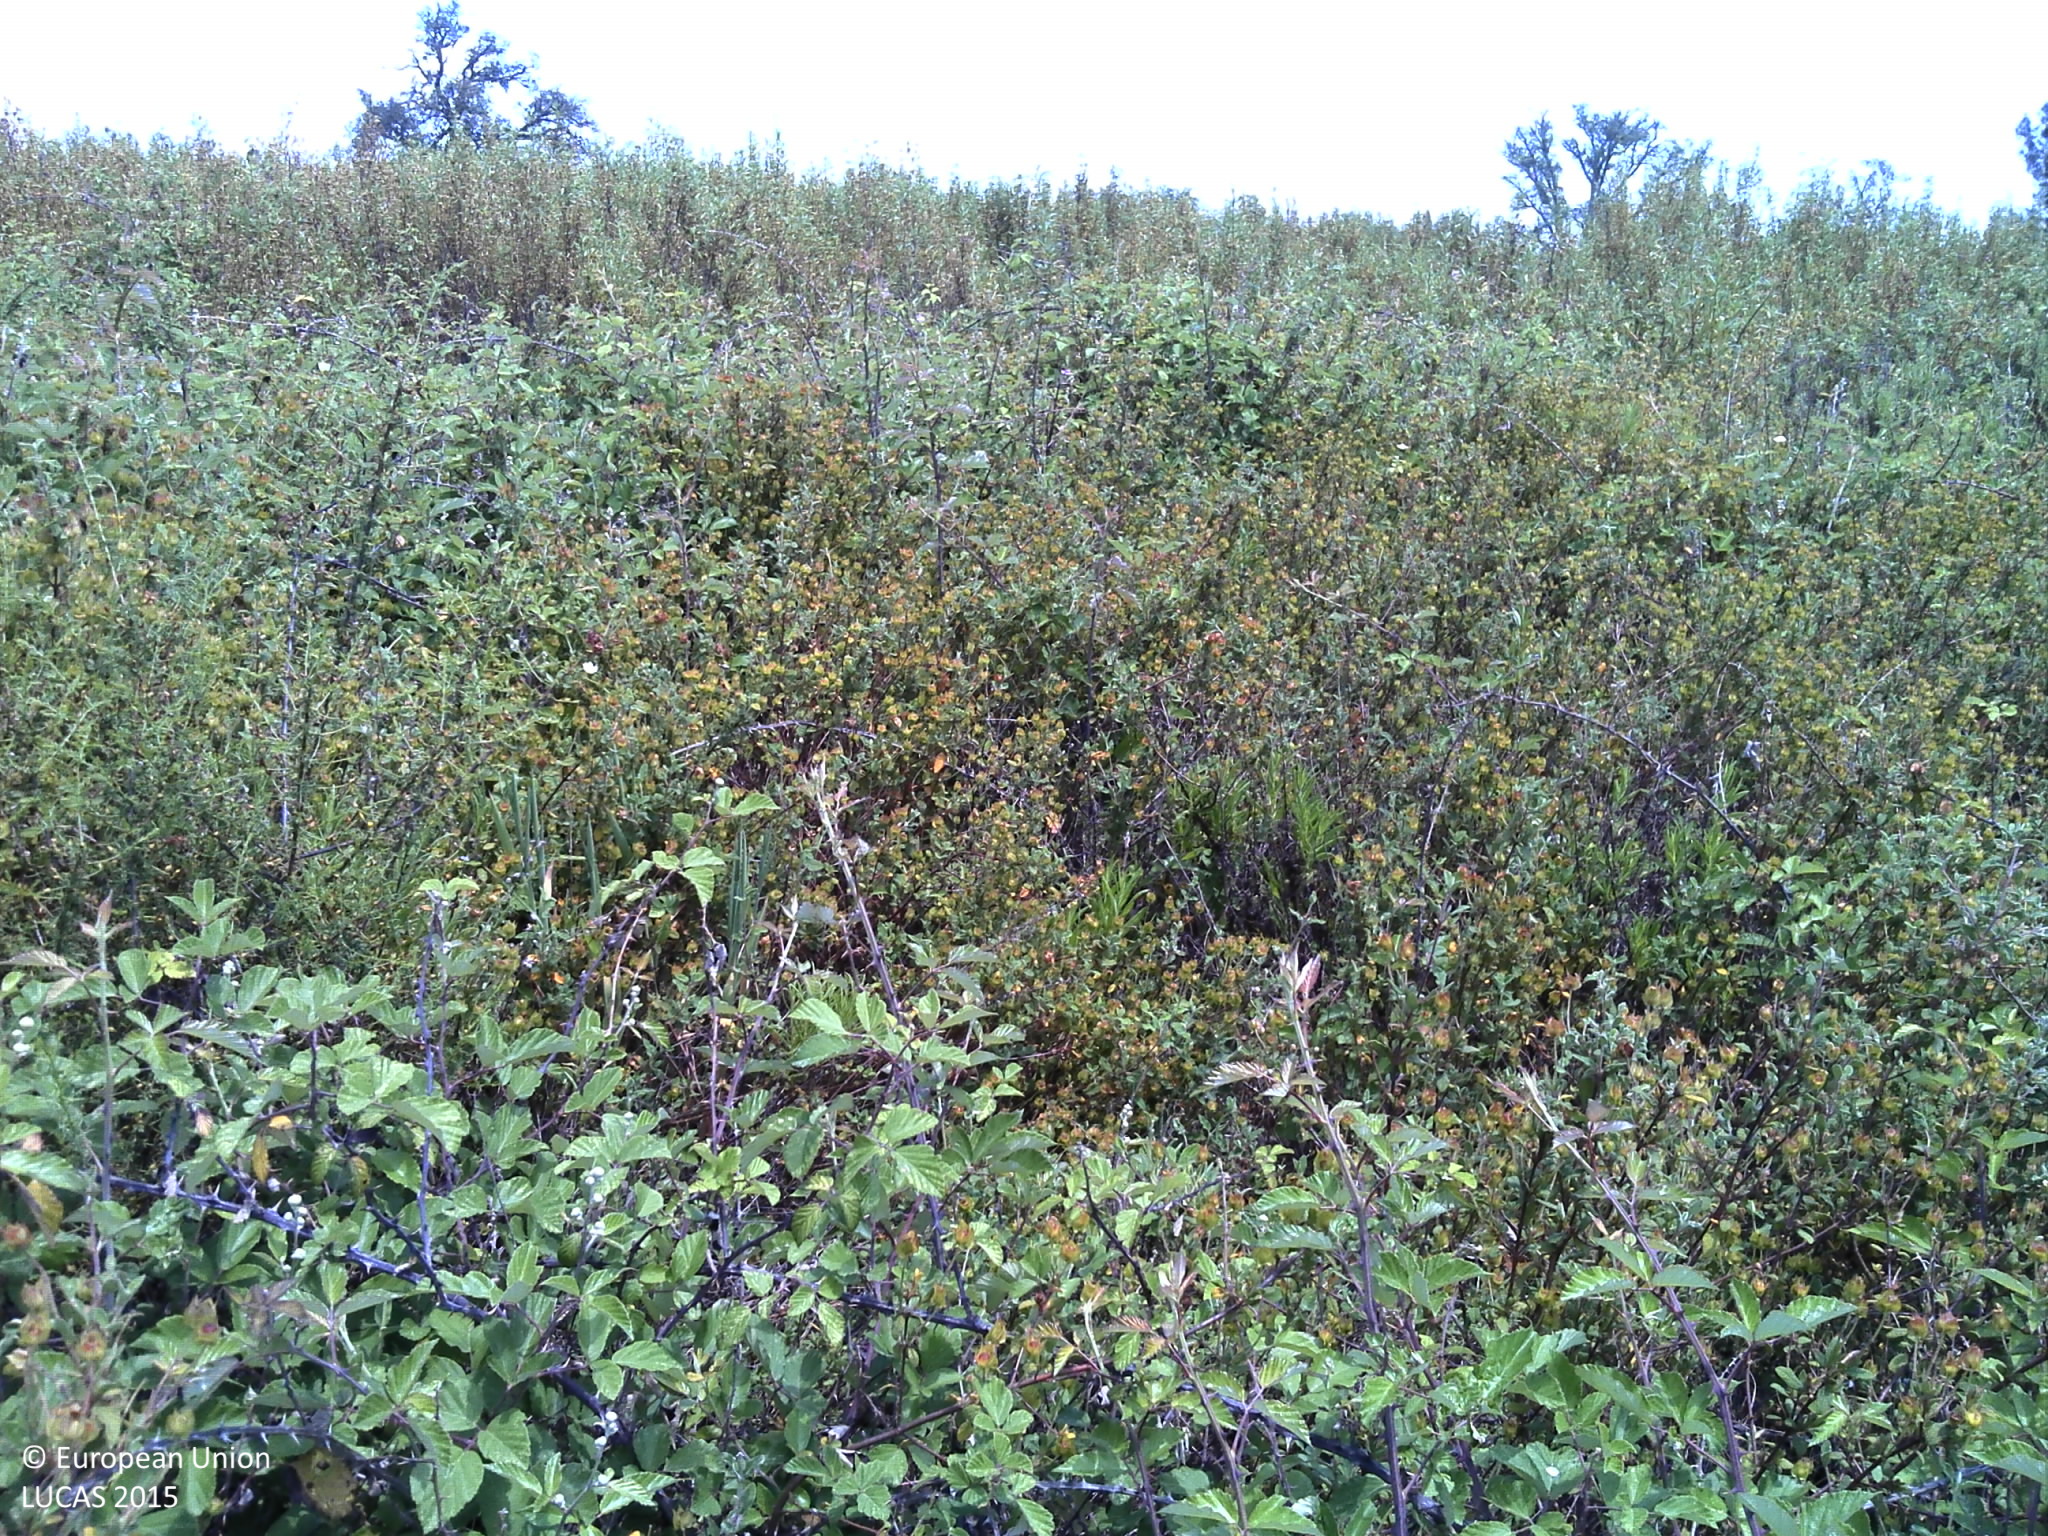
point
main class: Shrubland
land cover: Shrubland with sparse tree cover
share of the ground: > 75 %
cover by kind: shrubs 75 %, herbaceous plants 10 %, unconsolidated bare surface 10 %, broadleaved forest trees 5 %
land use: Semi-natural and natural areas not in use
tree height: < 5 m
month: May
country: PT
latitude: 37.8371
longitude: -8.5276
